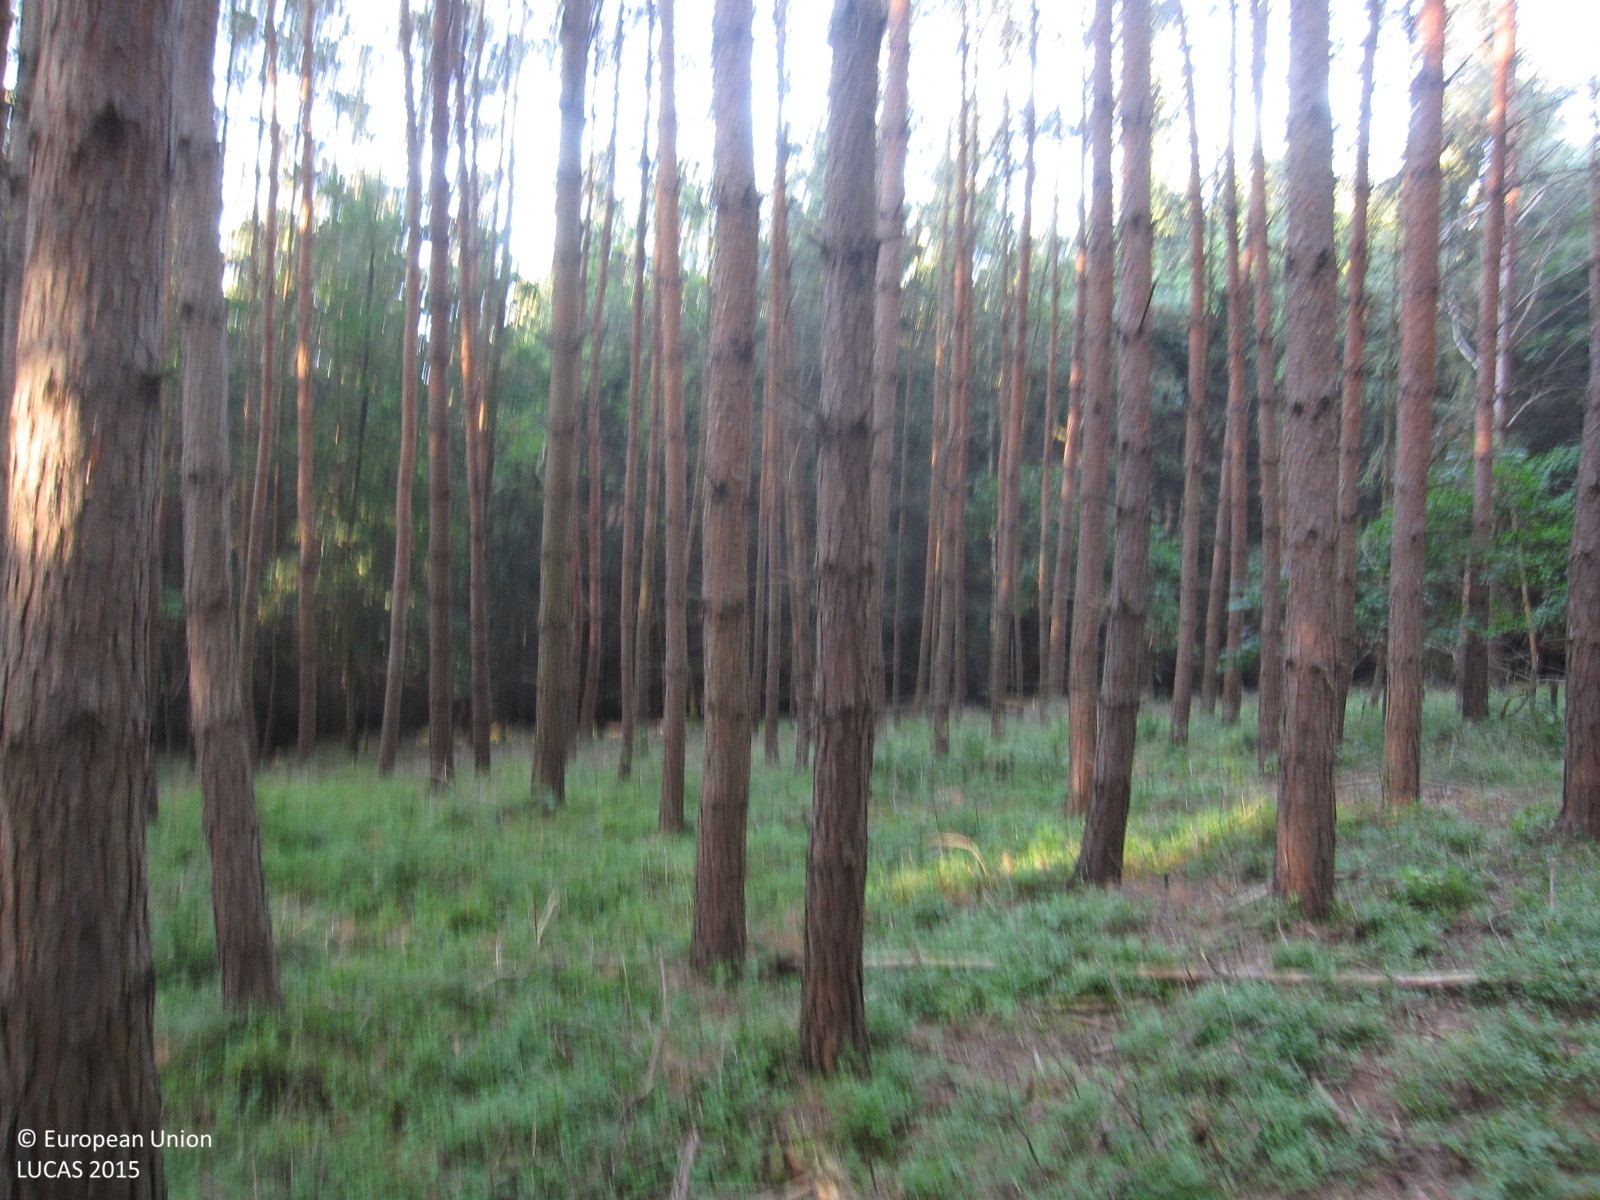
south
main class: Woodland
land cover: Pine dominated coniferous woodland
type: hemiboreal forest and nemoral coniferous forest and mixed broadleaved-coniferous forest
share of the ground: > 75 %
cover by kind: coniferous forest trees 90 %, herbaceous plants 5 %, unconsolidated bare surface 5 %
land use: Forestry
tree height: > 5 m
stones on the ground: 25 - 50 %
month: July
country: DE
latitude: 50.8681
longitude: 12.0032
